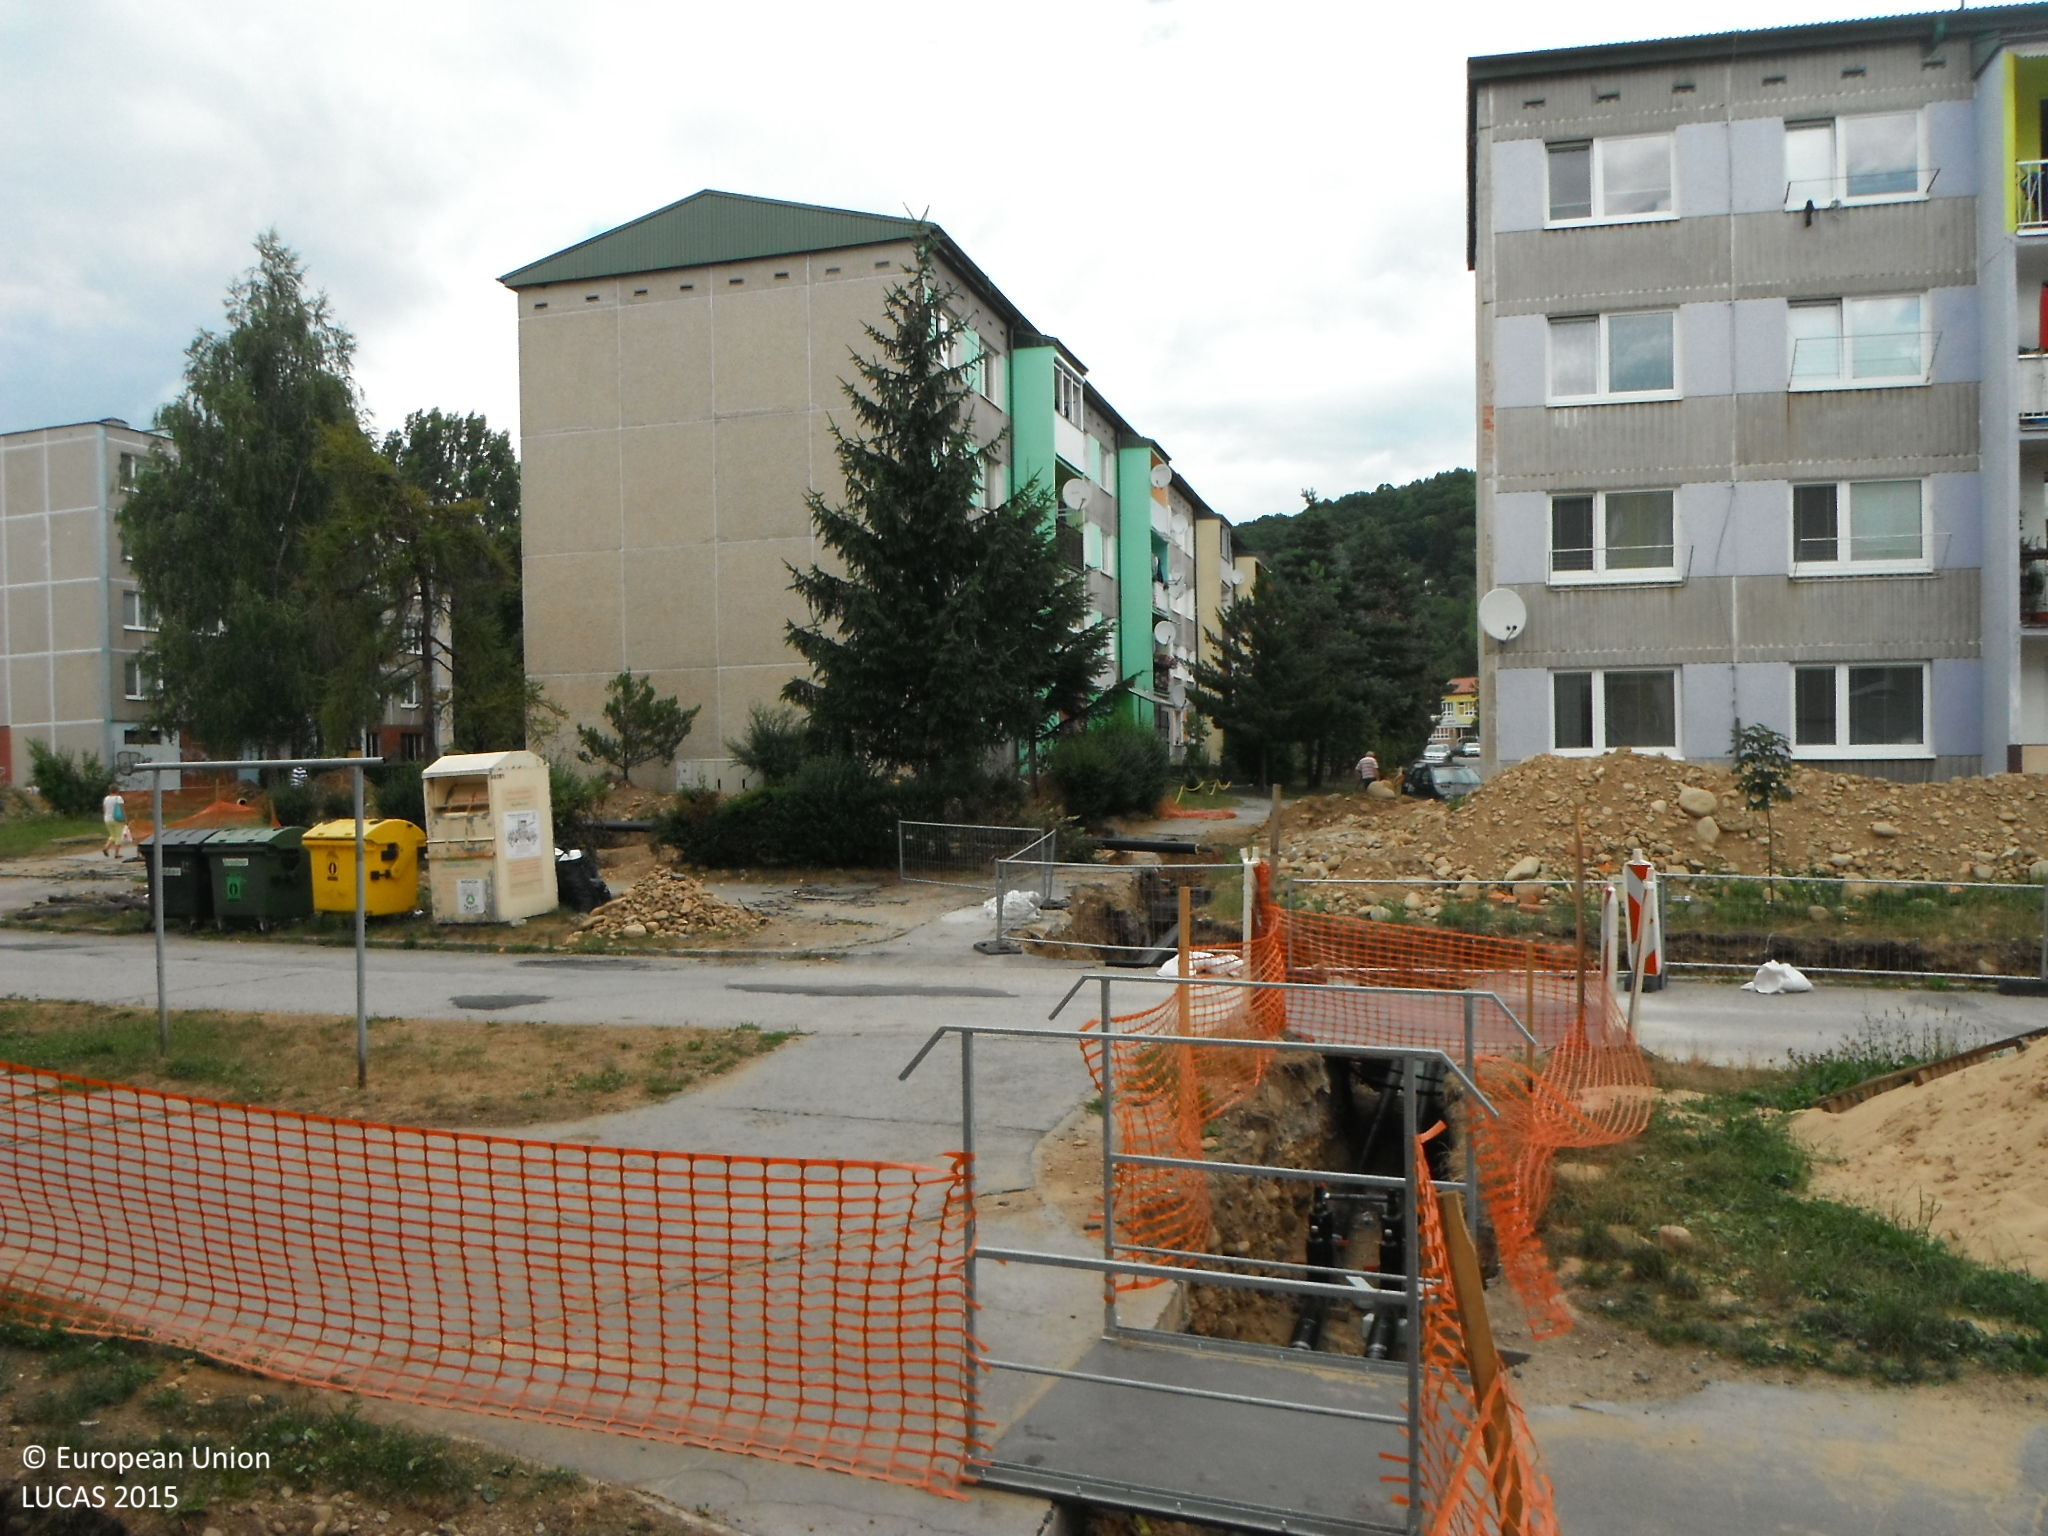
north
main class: Grassland
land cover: Grassland without tree/shrub cover
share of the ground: 25 - 50 %
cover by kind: herbaceous plants 50 %
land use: Residential
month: July
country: SK
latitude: 48.6811
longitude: 20.1228
